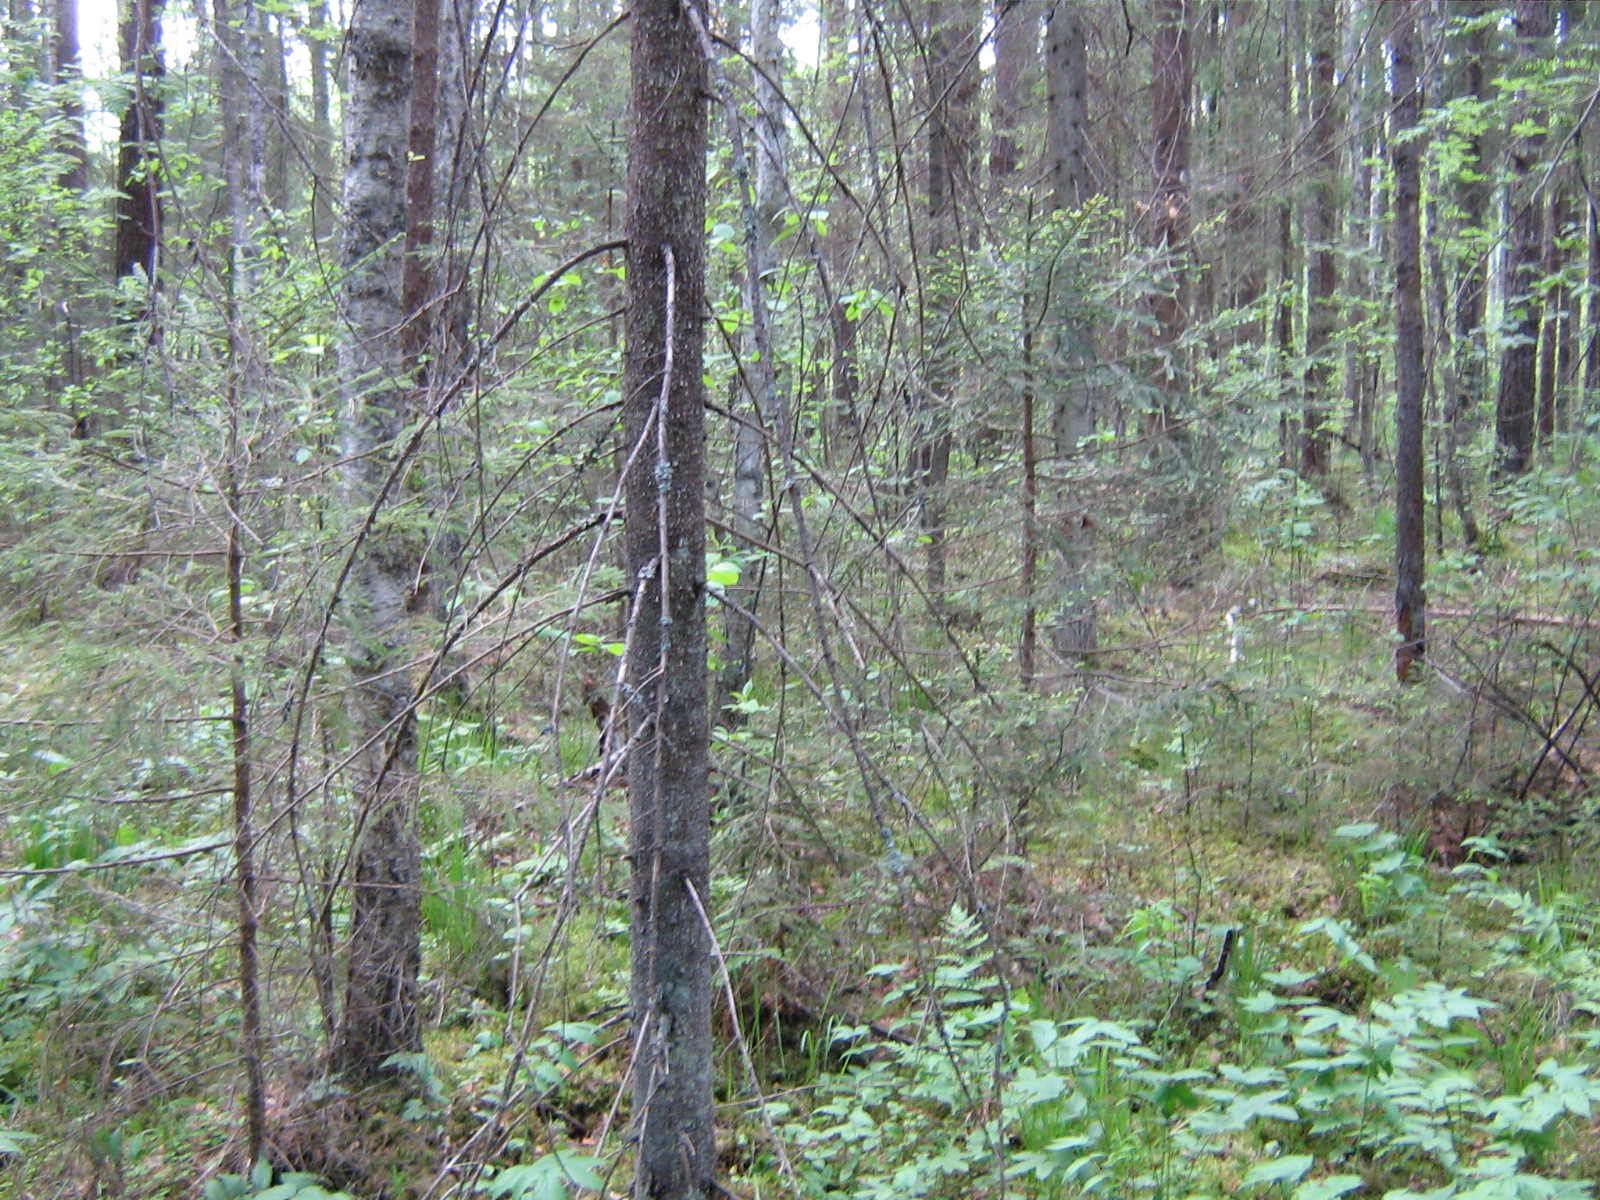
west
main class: Woodland
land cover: Spruce dominated mixed woodland
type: hemiboreal forest and nemoral coniferous forest and mixed broadleaved-coniferous forest
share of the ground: > 75 %
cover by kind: coniferous forest trees 70 %, broadleaved forest trees 30 %
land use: Forestry
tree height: > 5 m
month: June
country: LV
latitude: 57.1944
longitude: 25.8646
